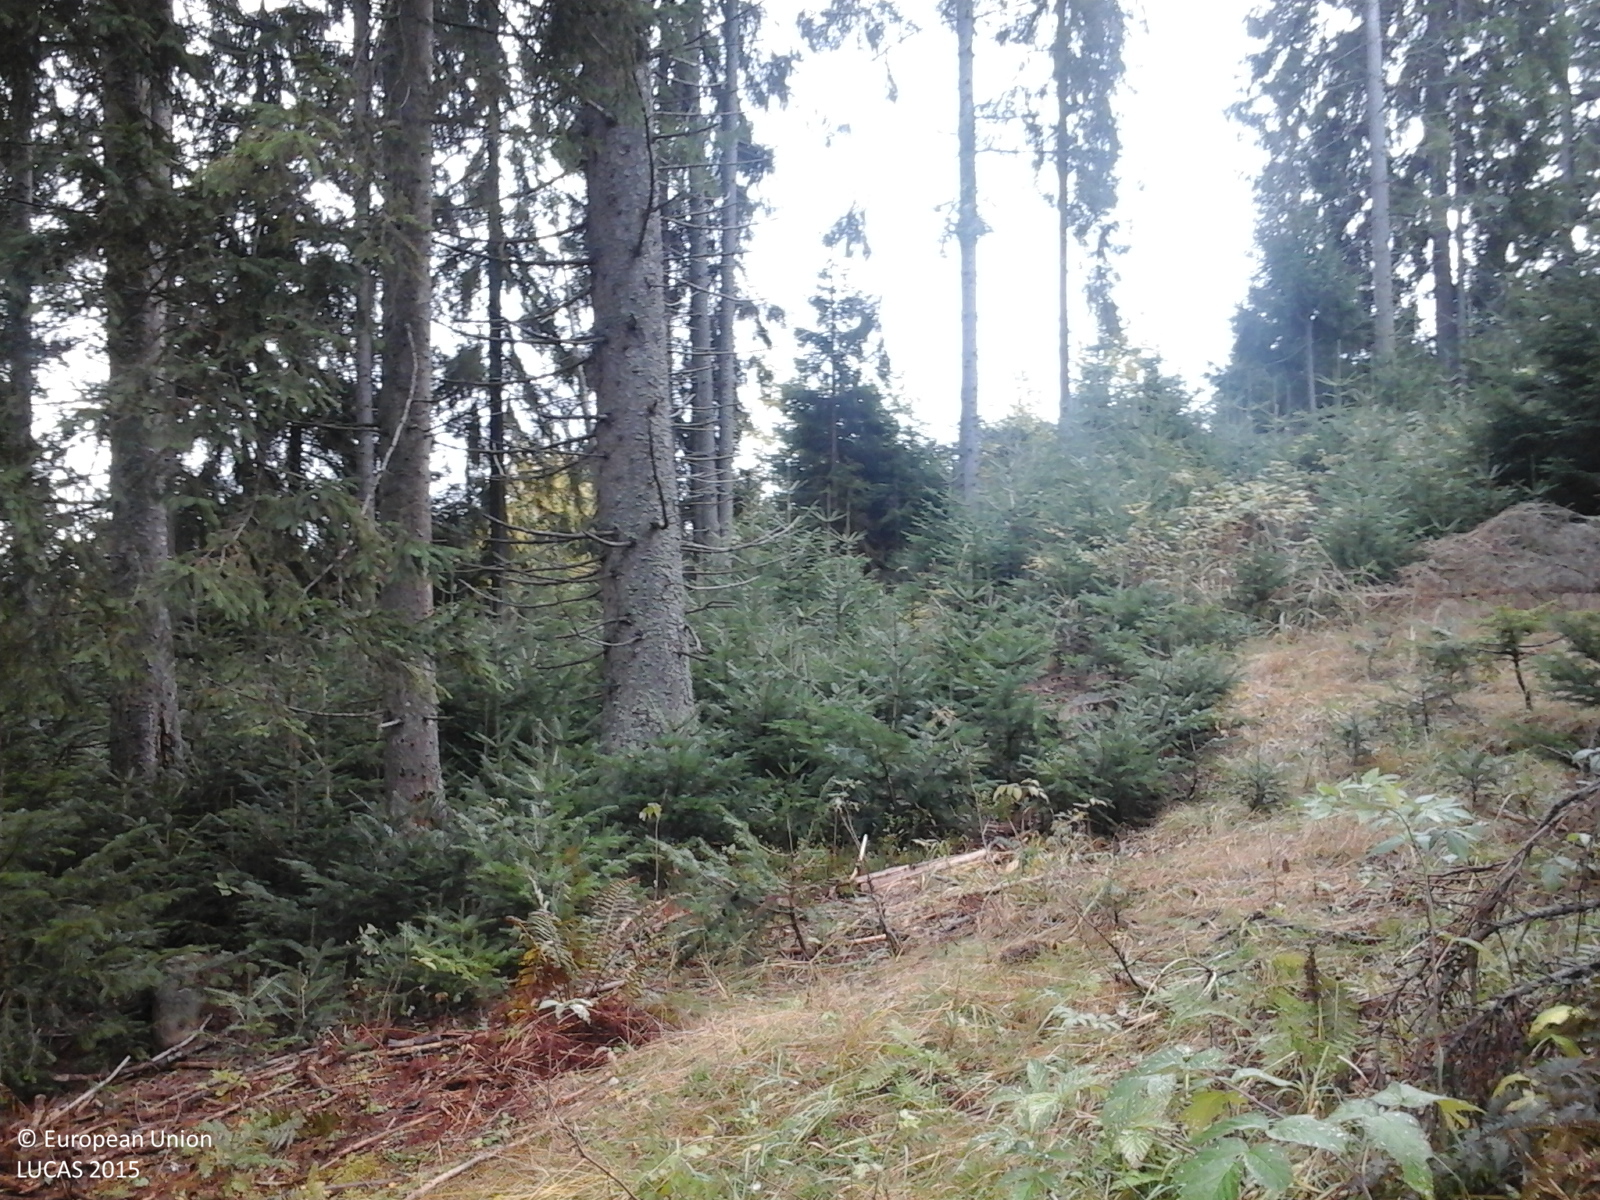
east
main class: Woodland
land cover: Other coniferous woodland
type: alpine coniferous forest
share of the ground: > 75 %
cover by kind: coniferous forest trees 75 %, broadleaved forest trees 10 %, herbaceous plants 10 %, shrubs 5 %
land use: Forestry
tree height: > 5 m
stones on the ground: < 10 %
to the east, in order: Other coniferous woodland; Tracks; Other coniferous woodland
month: October
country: RO
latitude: 46.8319
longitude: 25.3281
